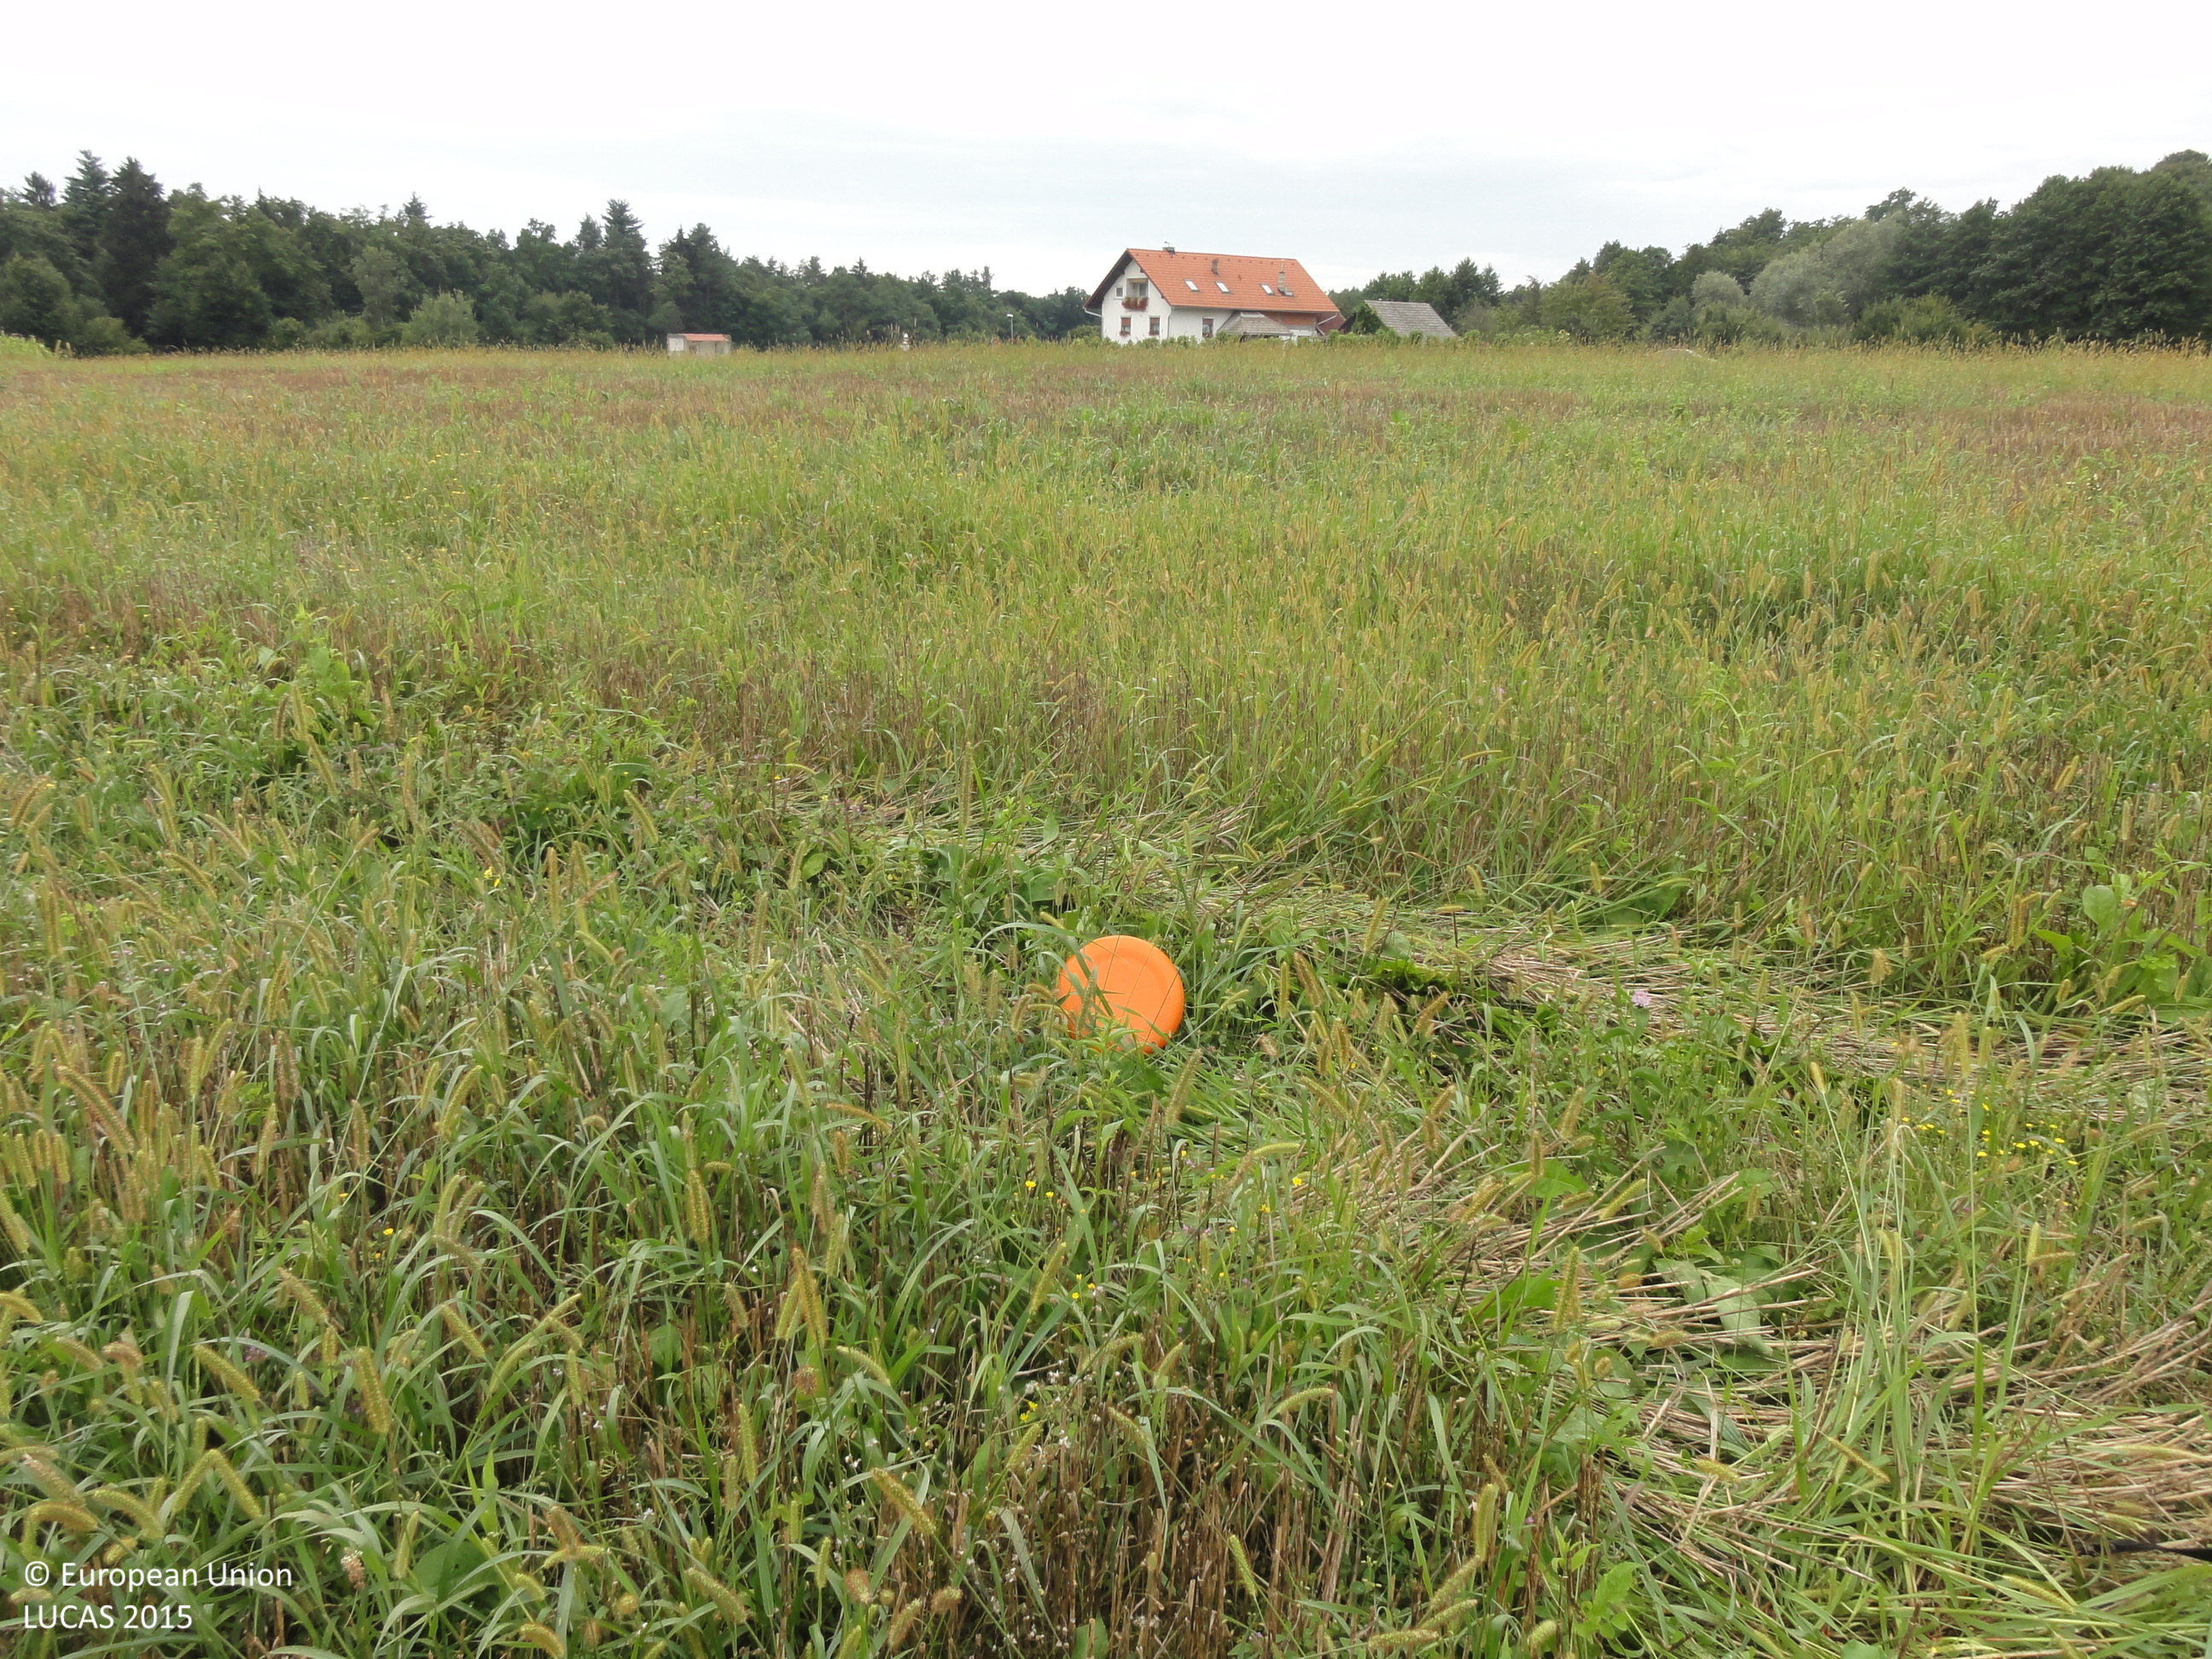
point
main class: Cropland
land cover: Common wheat
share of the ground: < 10 %
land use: Agriculture (excluding fallow land and kitchen gardens)
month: August
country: SI
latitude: 45.9413
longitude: 15.4535
